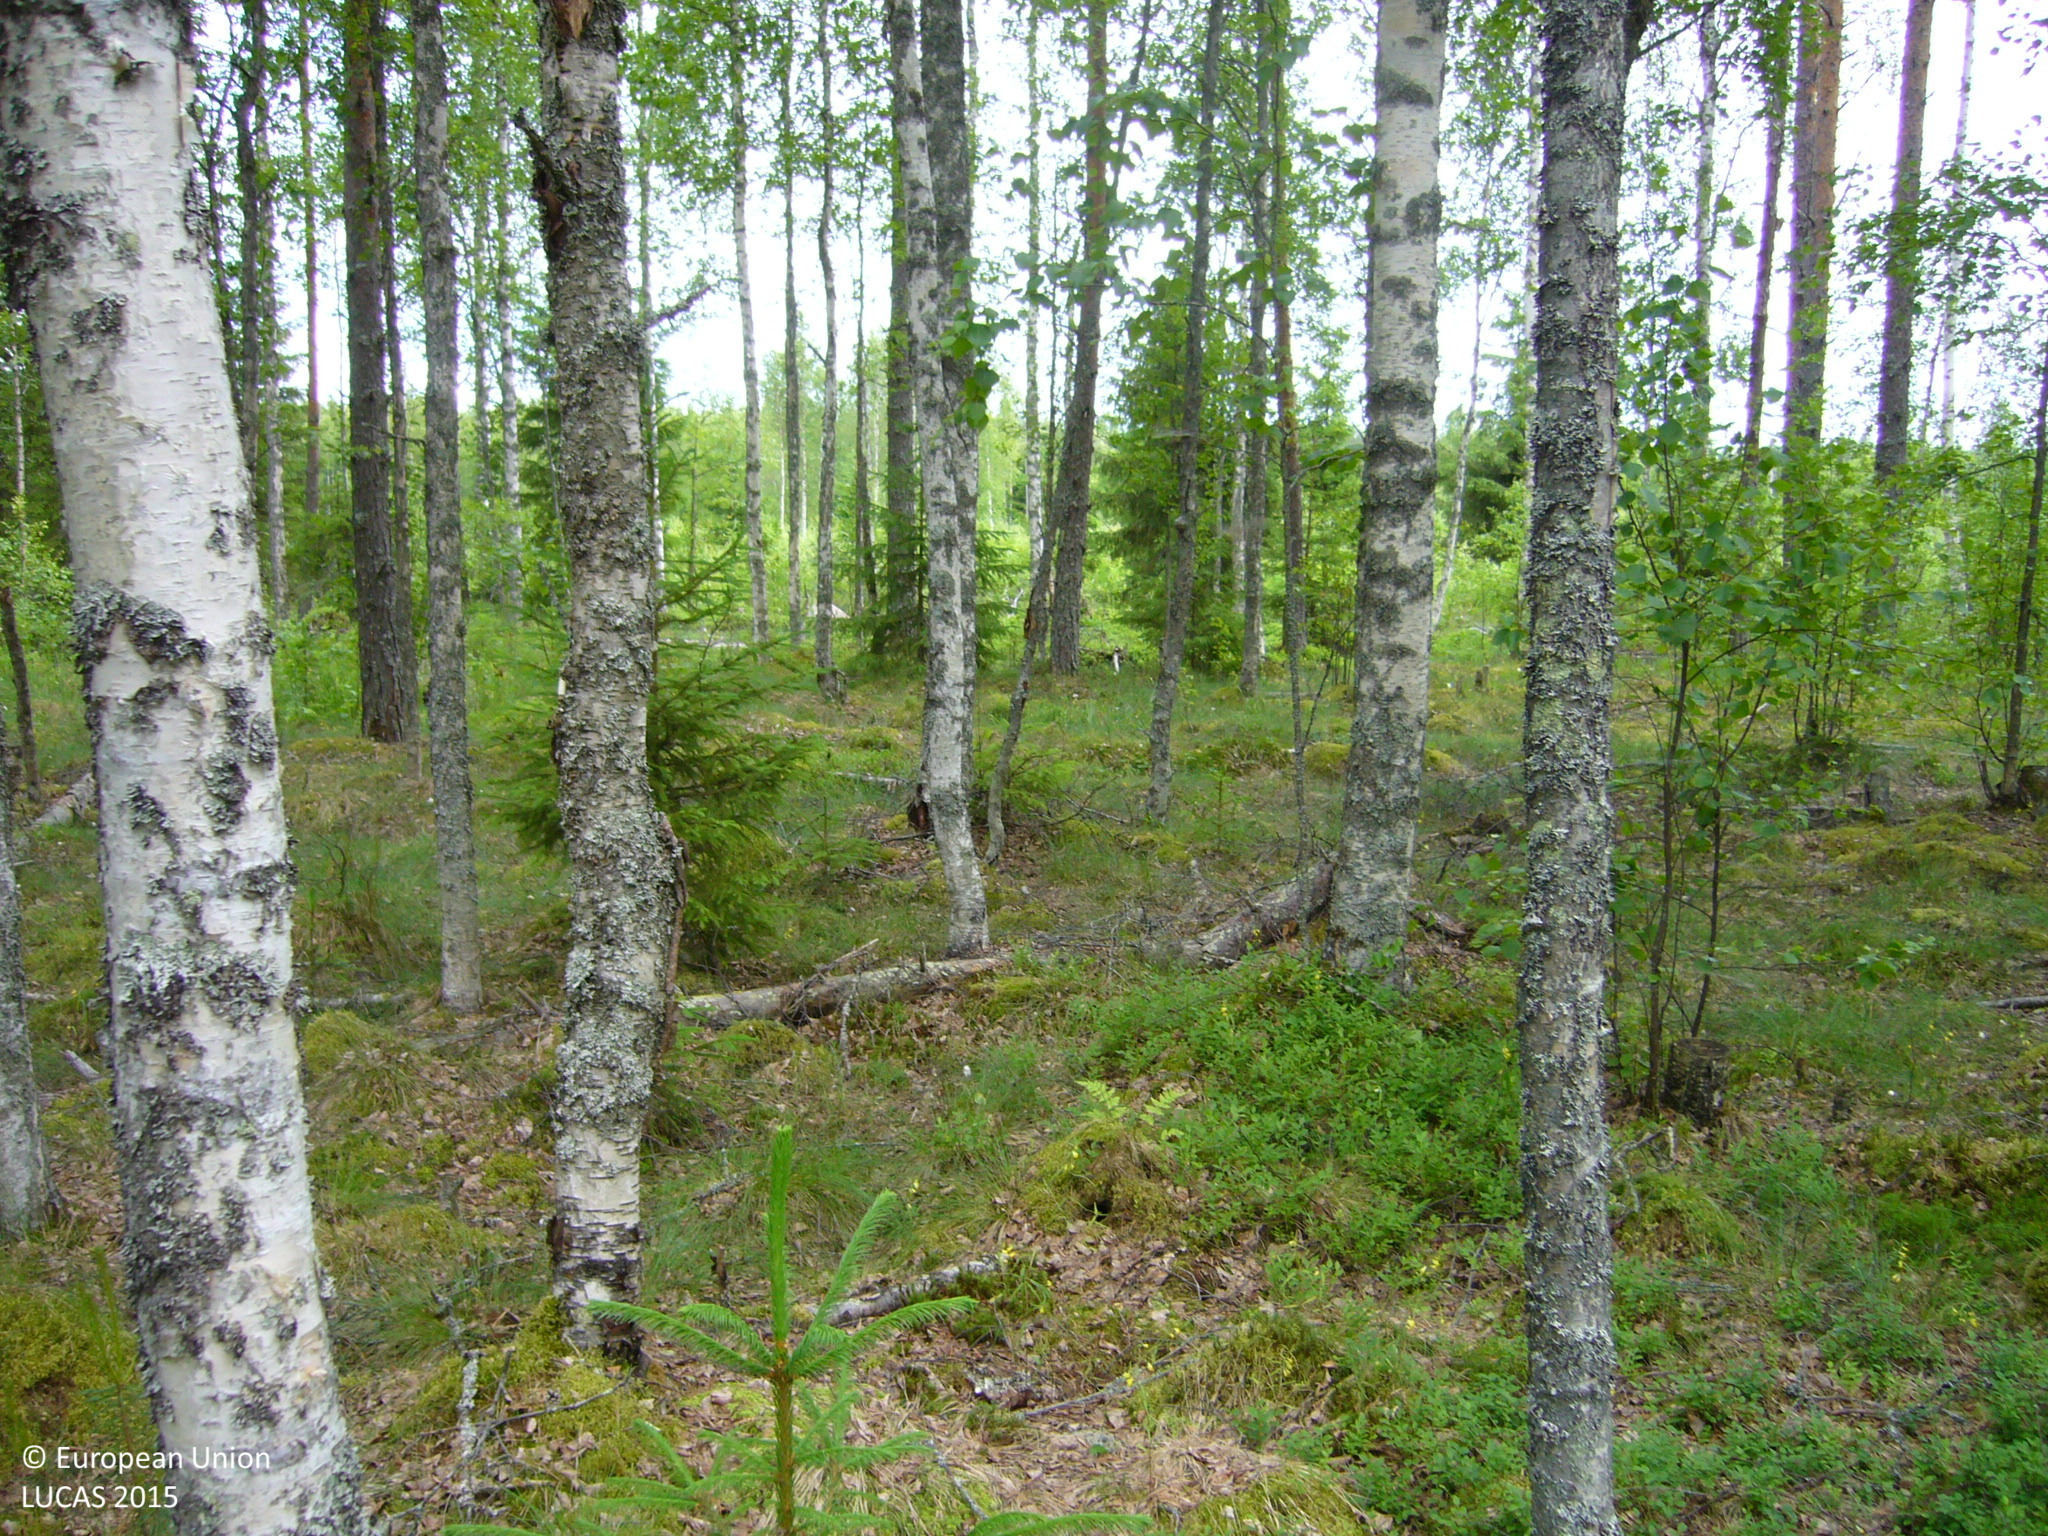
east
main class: Woodland
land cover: Pine dominated mixed woodland
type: boreal forest
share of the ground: 50 - 75 %
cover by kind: broadleaved forest trees 40 %, shrubs 35 %, coniferous forest trees 25 %
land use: Forestry
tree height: > 5 m
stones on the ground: 10 - 25 %
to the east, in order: Pine dominated mixed woodland; Ditches and canals; Spruce dominated mixed woodland; Ditches and canals; Spruce dominated mixed woodland; Ditches and canals; Spruce dominated mixed woodland; Ditches and canals; Spruce dominated mixed woodland; Ditches and canals; Broadleaved woodland; Ditches and canals; Broadleaved woodland
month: July
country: FI
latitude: 63.2345
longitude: 26.1015
